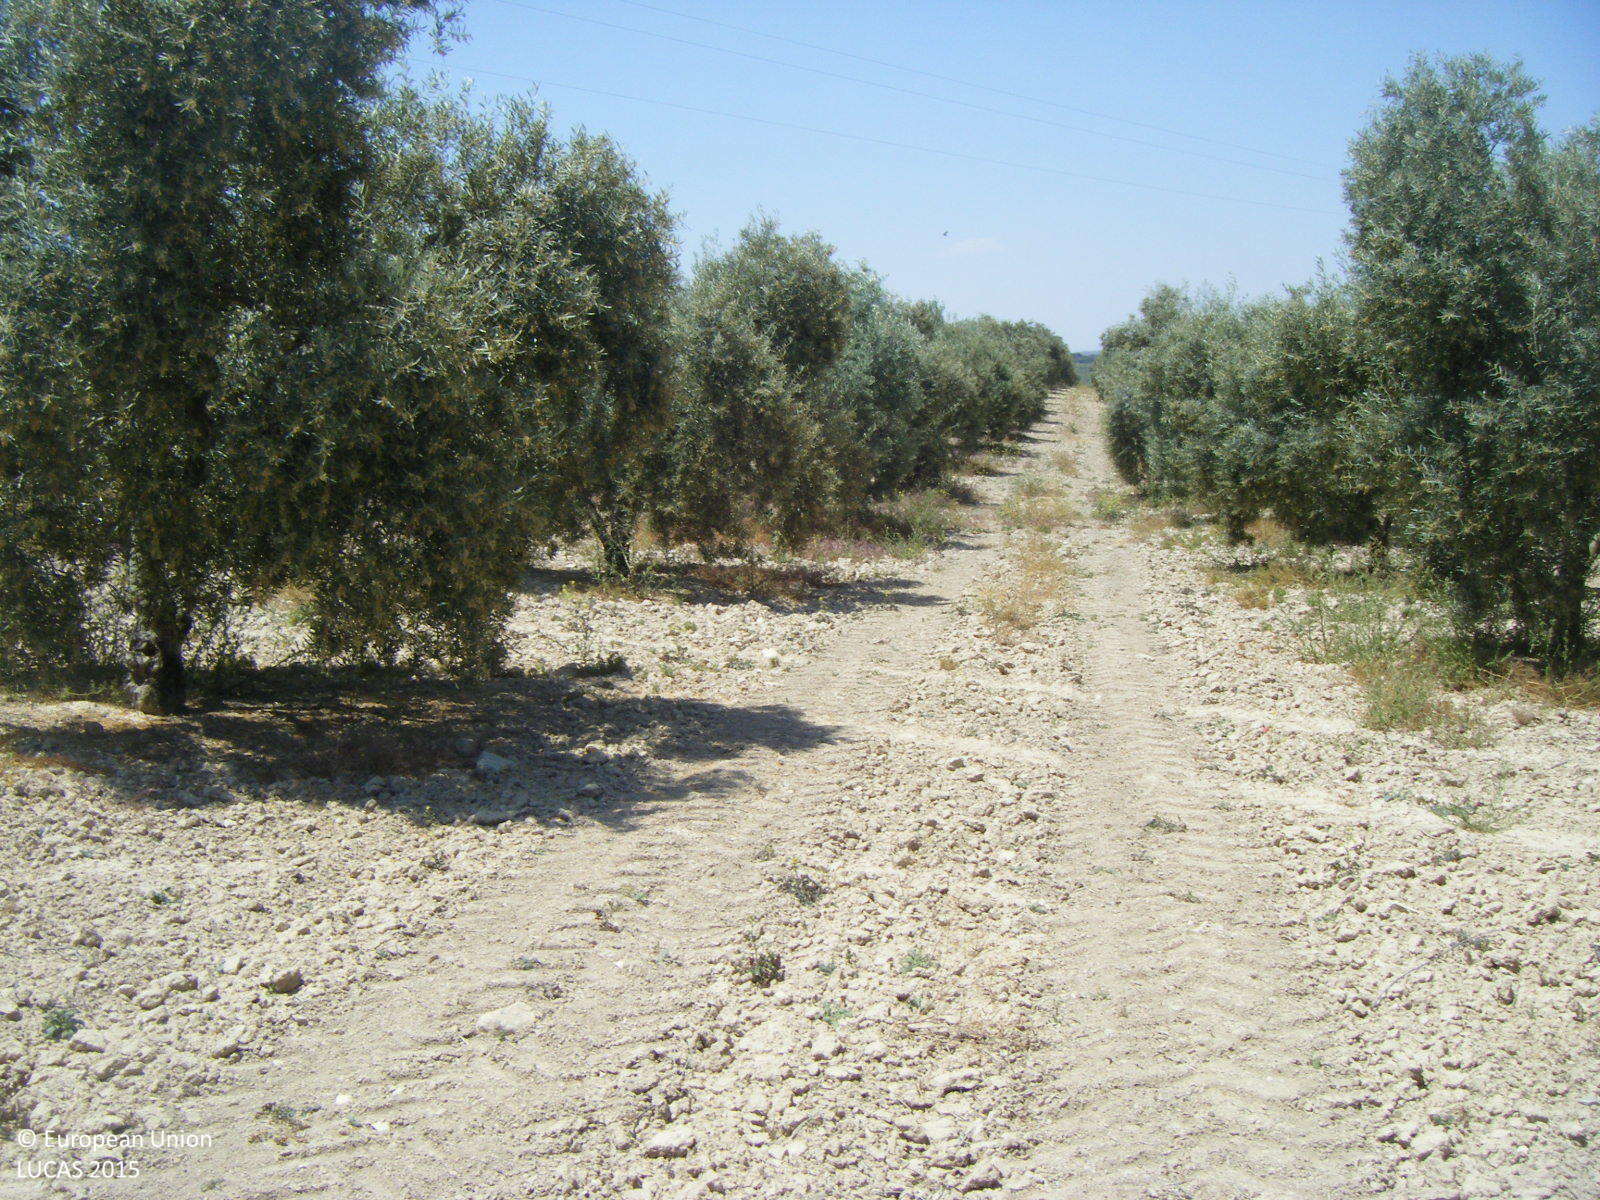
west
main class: Cropland
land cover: Olive groves
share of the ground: 10 - 25 %
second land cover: Other bare soil
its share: > 75 %
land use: Agriculture (excluding fallow land and kitchen gardens)
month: May
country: ES
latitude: 37.1432
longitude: -4.5101
